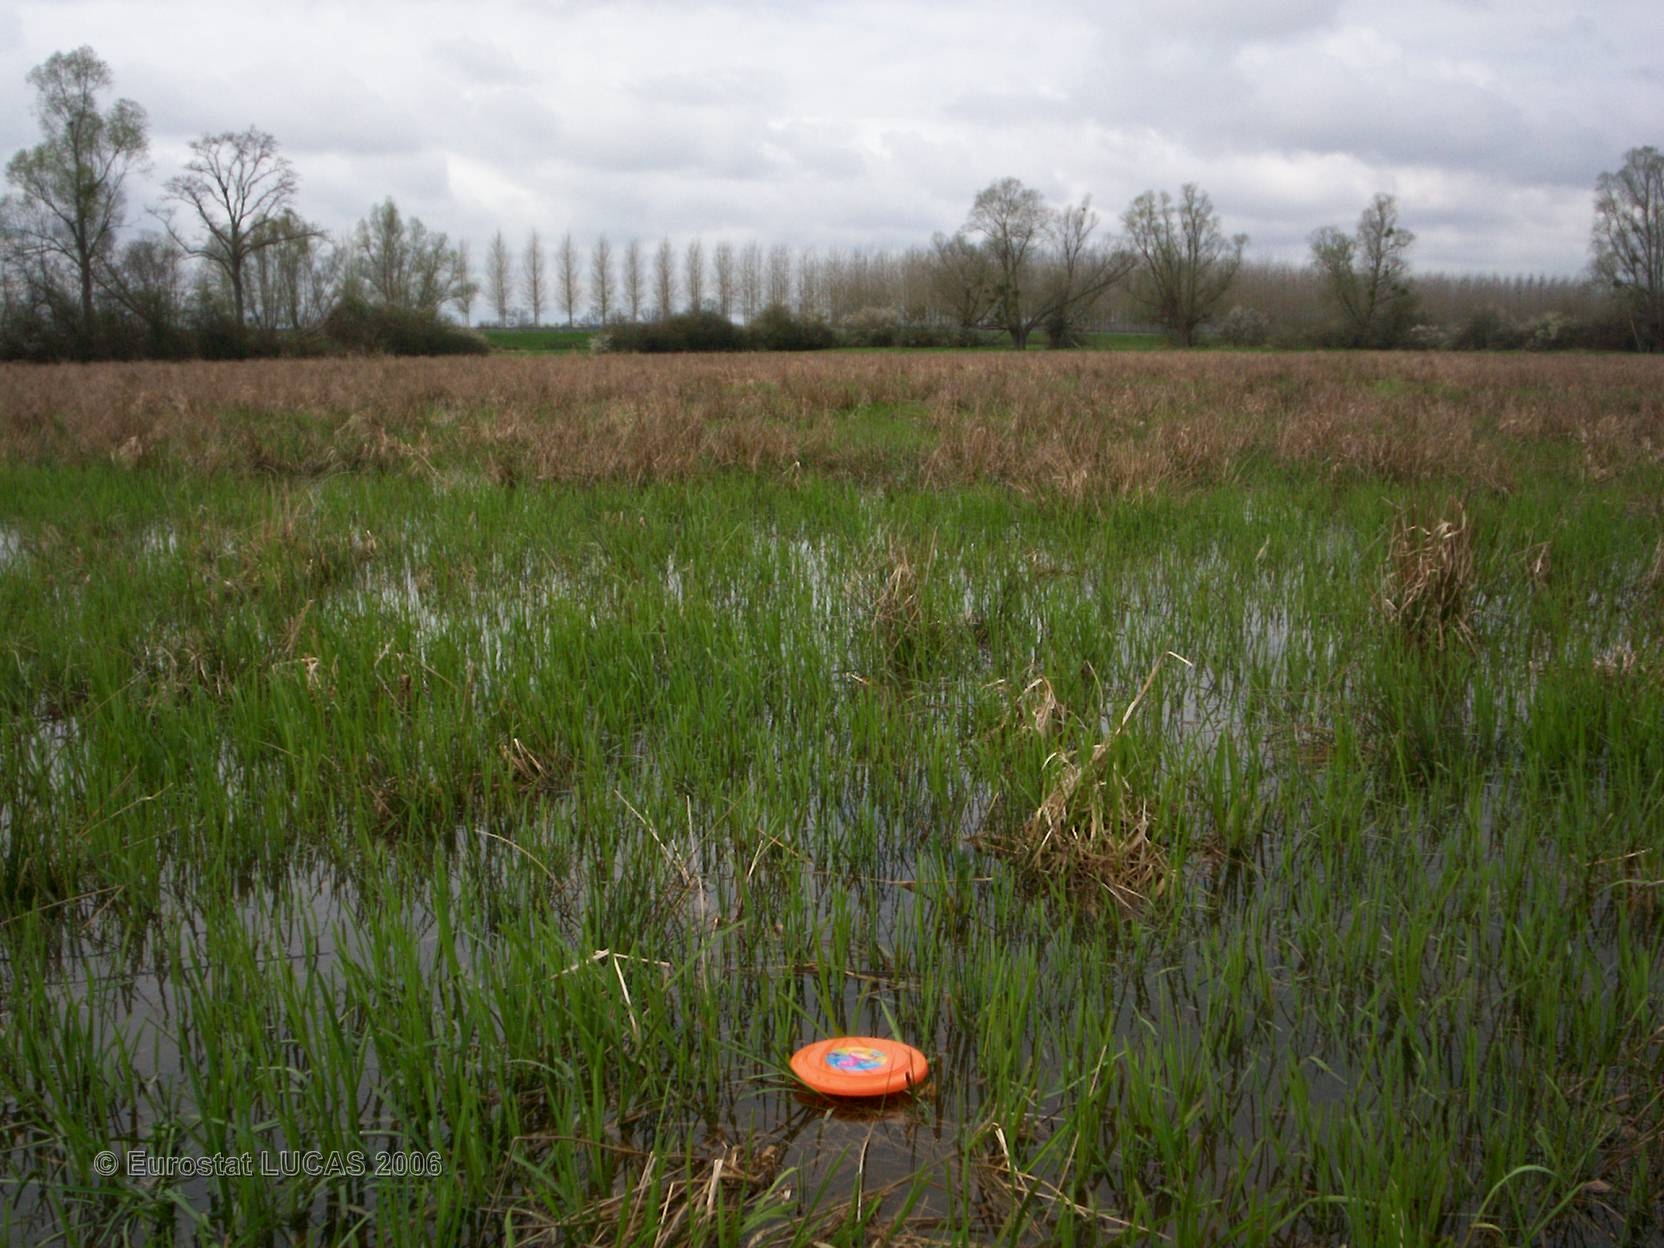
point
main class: Grassland
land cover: Grassland without tree/shrub cover
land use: Agriculture (excluding fallow land and kitchen gardens)
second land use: Wetland
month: April
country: FR
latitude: 46.8127
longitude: 3.0637
